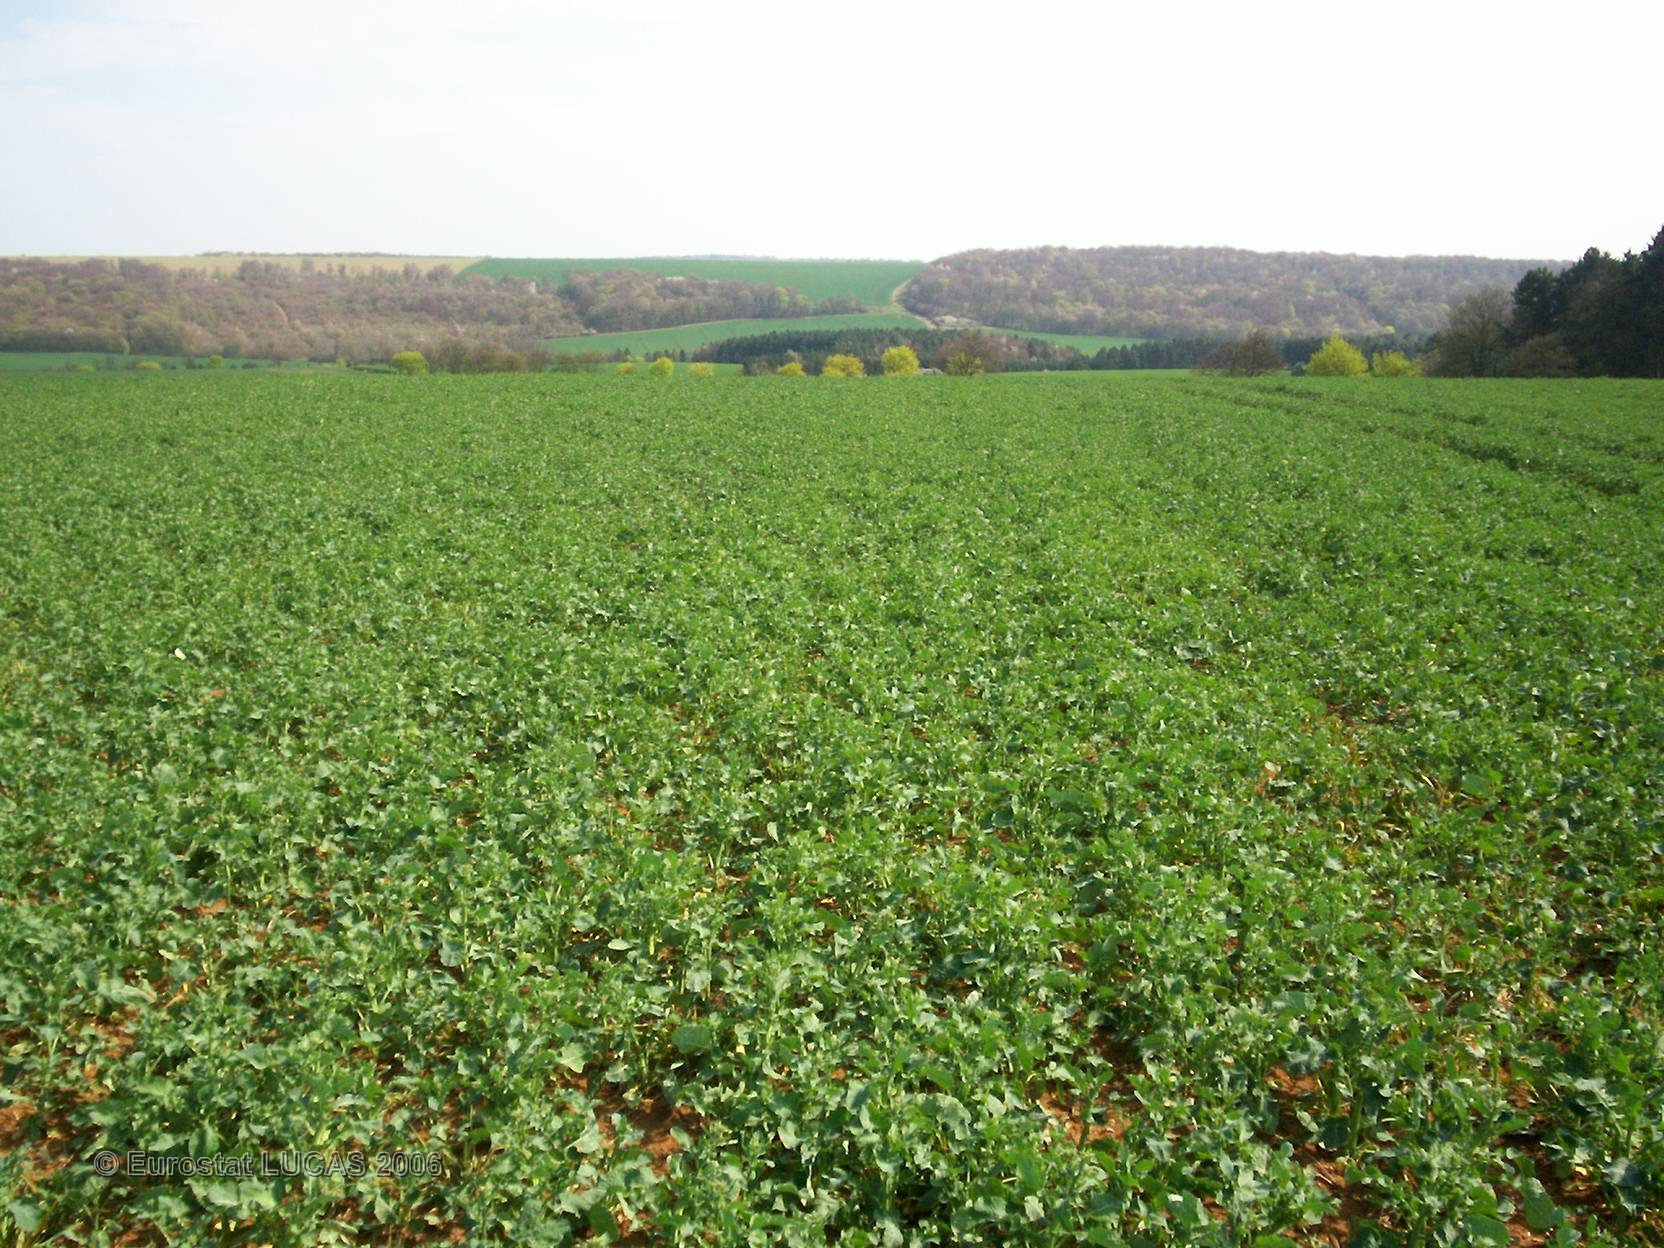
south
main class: Cropland
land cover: Rape and turnip rape
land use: Agriculture (excluding fallow land and kitchen gardens)
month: April
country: FR
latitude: 49.0494
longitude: 5.9358
